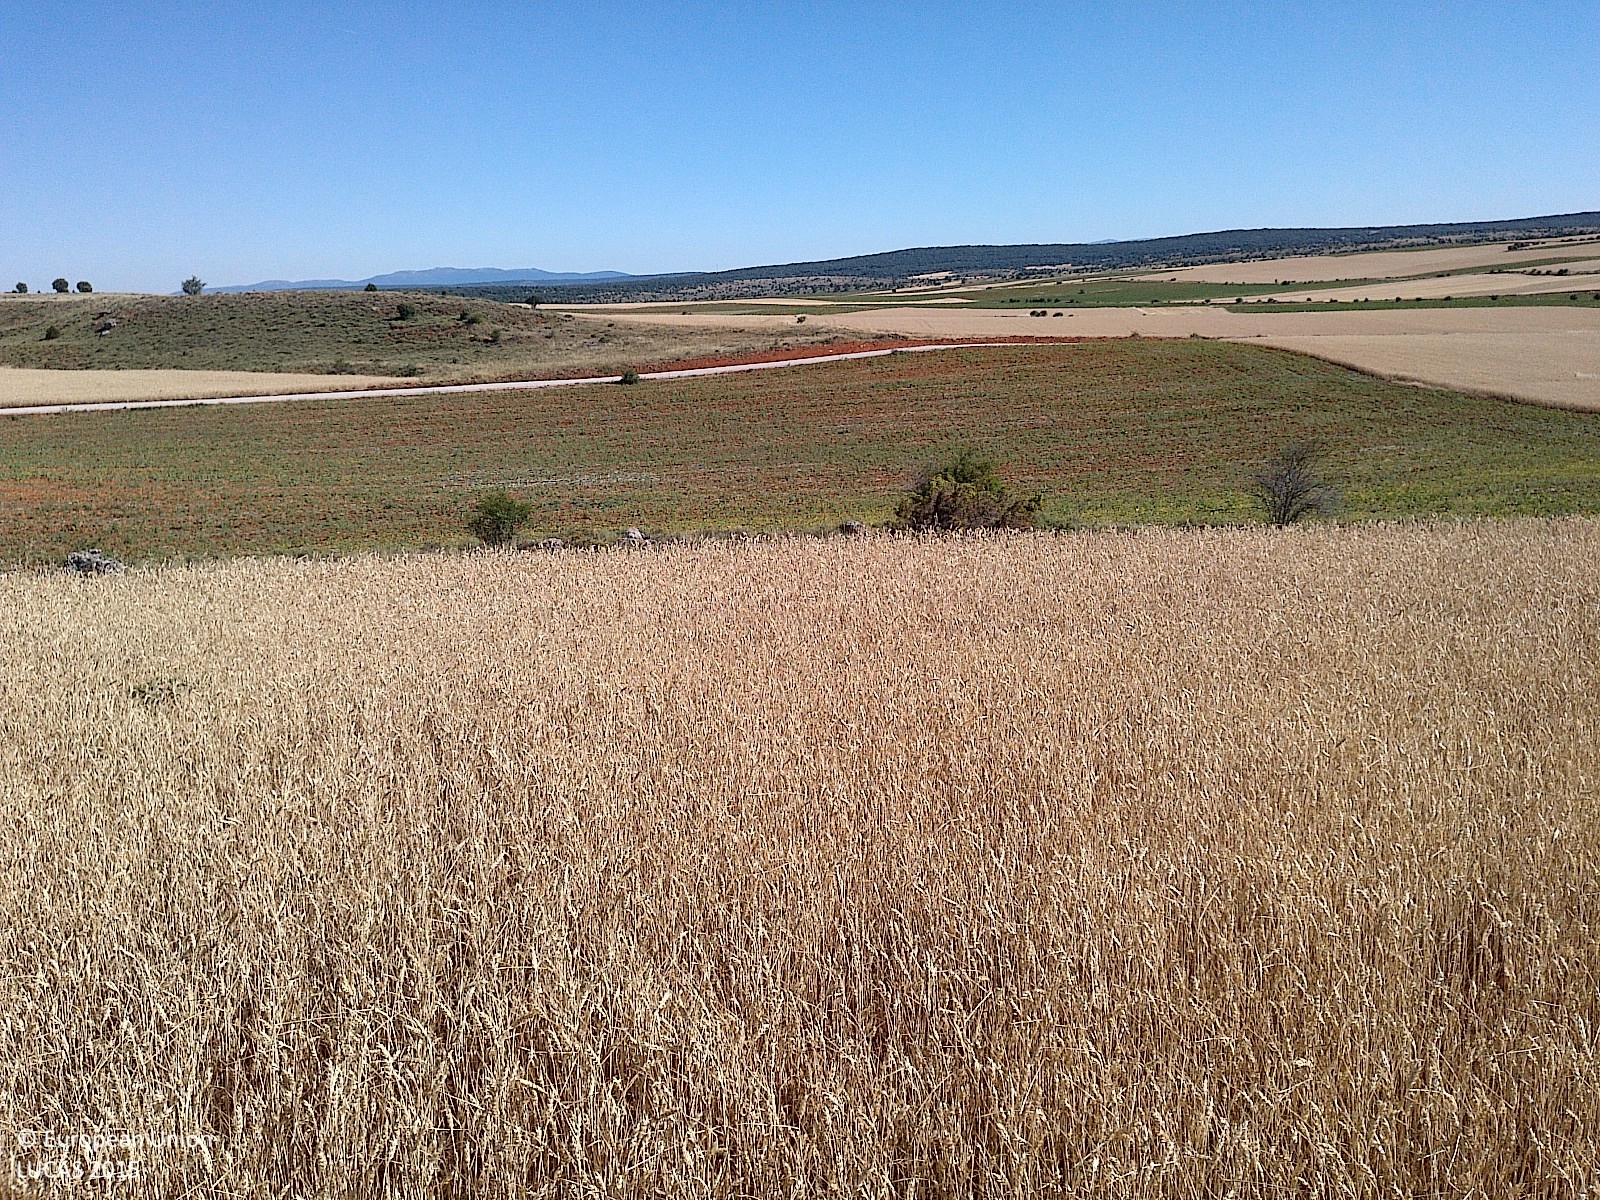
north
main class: Cropland
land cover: Common wheat
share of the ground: > 75 %
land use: Agriculture (excluding fallow land and kitchen gardens)
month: July
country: ES
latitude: 41.6579
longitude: -2.7818
